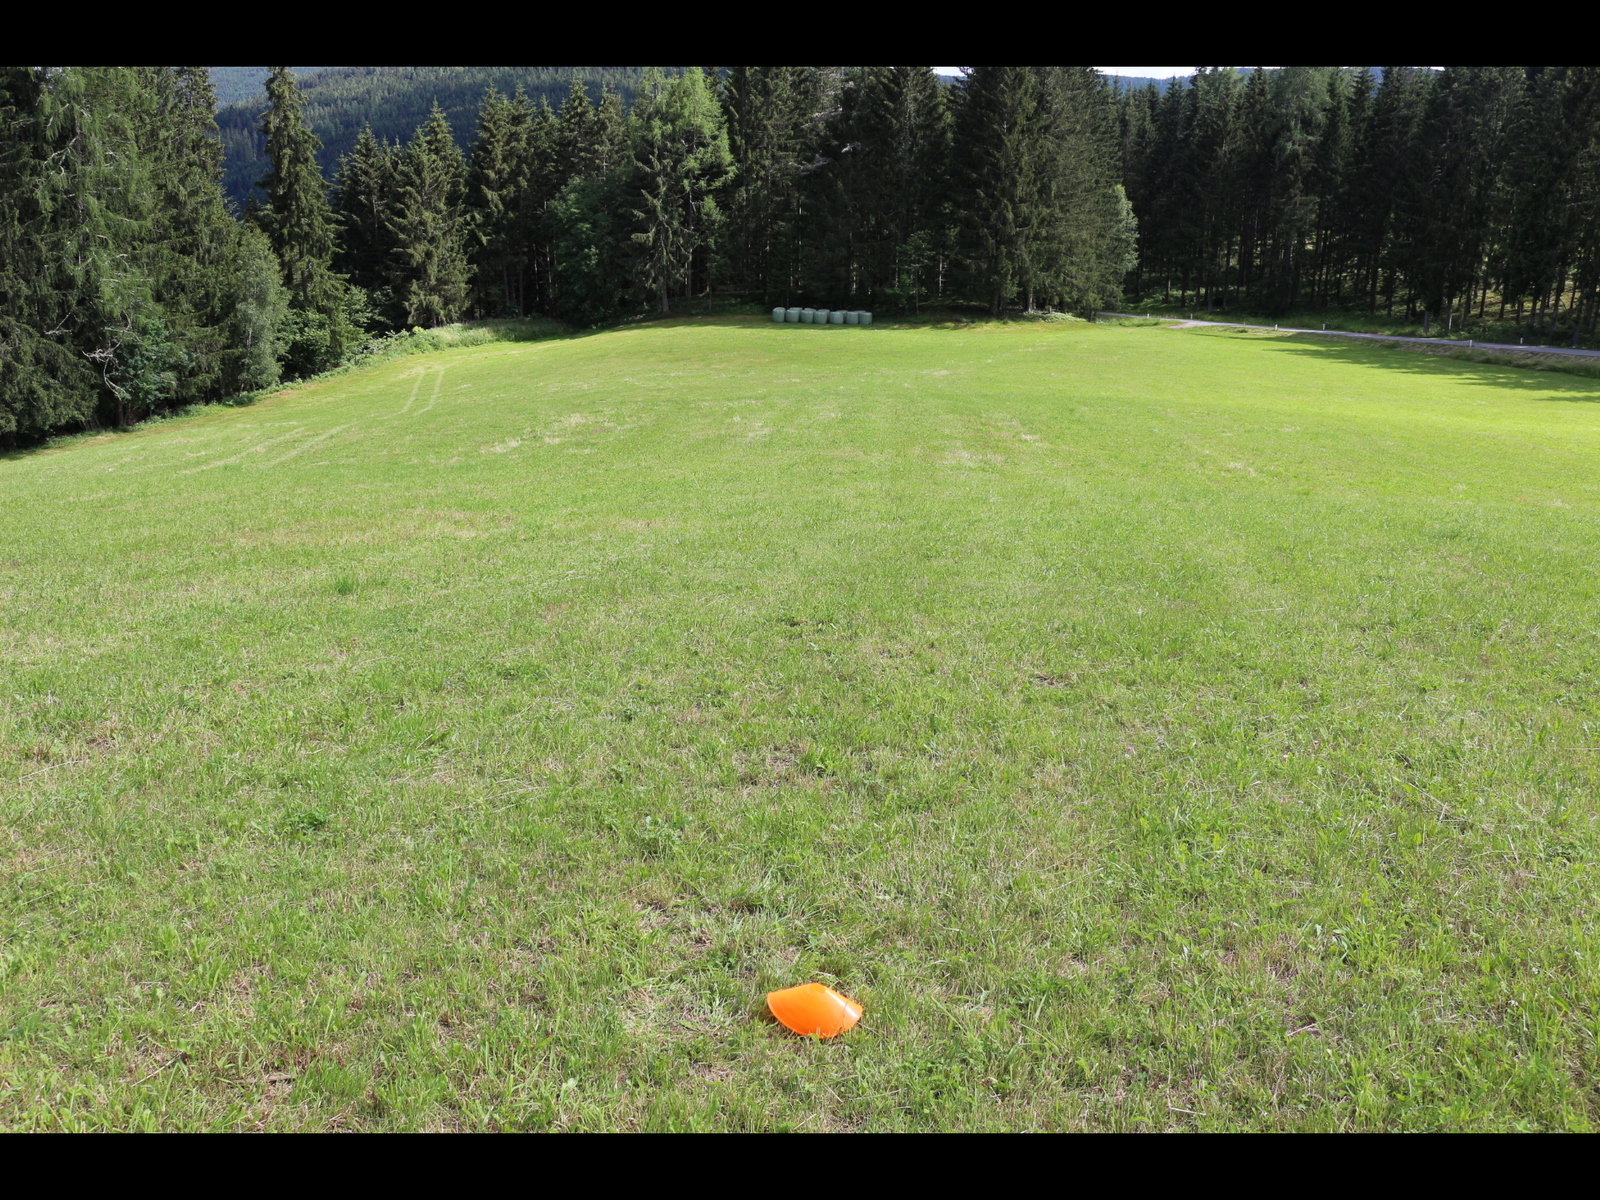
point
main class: Grassland
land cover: Grassland without tree/shrub cover
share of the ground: > 75 %
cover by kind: herbaceous plants 100 %
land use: Agriculture (excluding fallow land and kitchen gardens)
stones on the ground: < 10 %
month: June
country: AT
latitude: 46.8424
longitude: 14.2857
